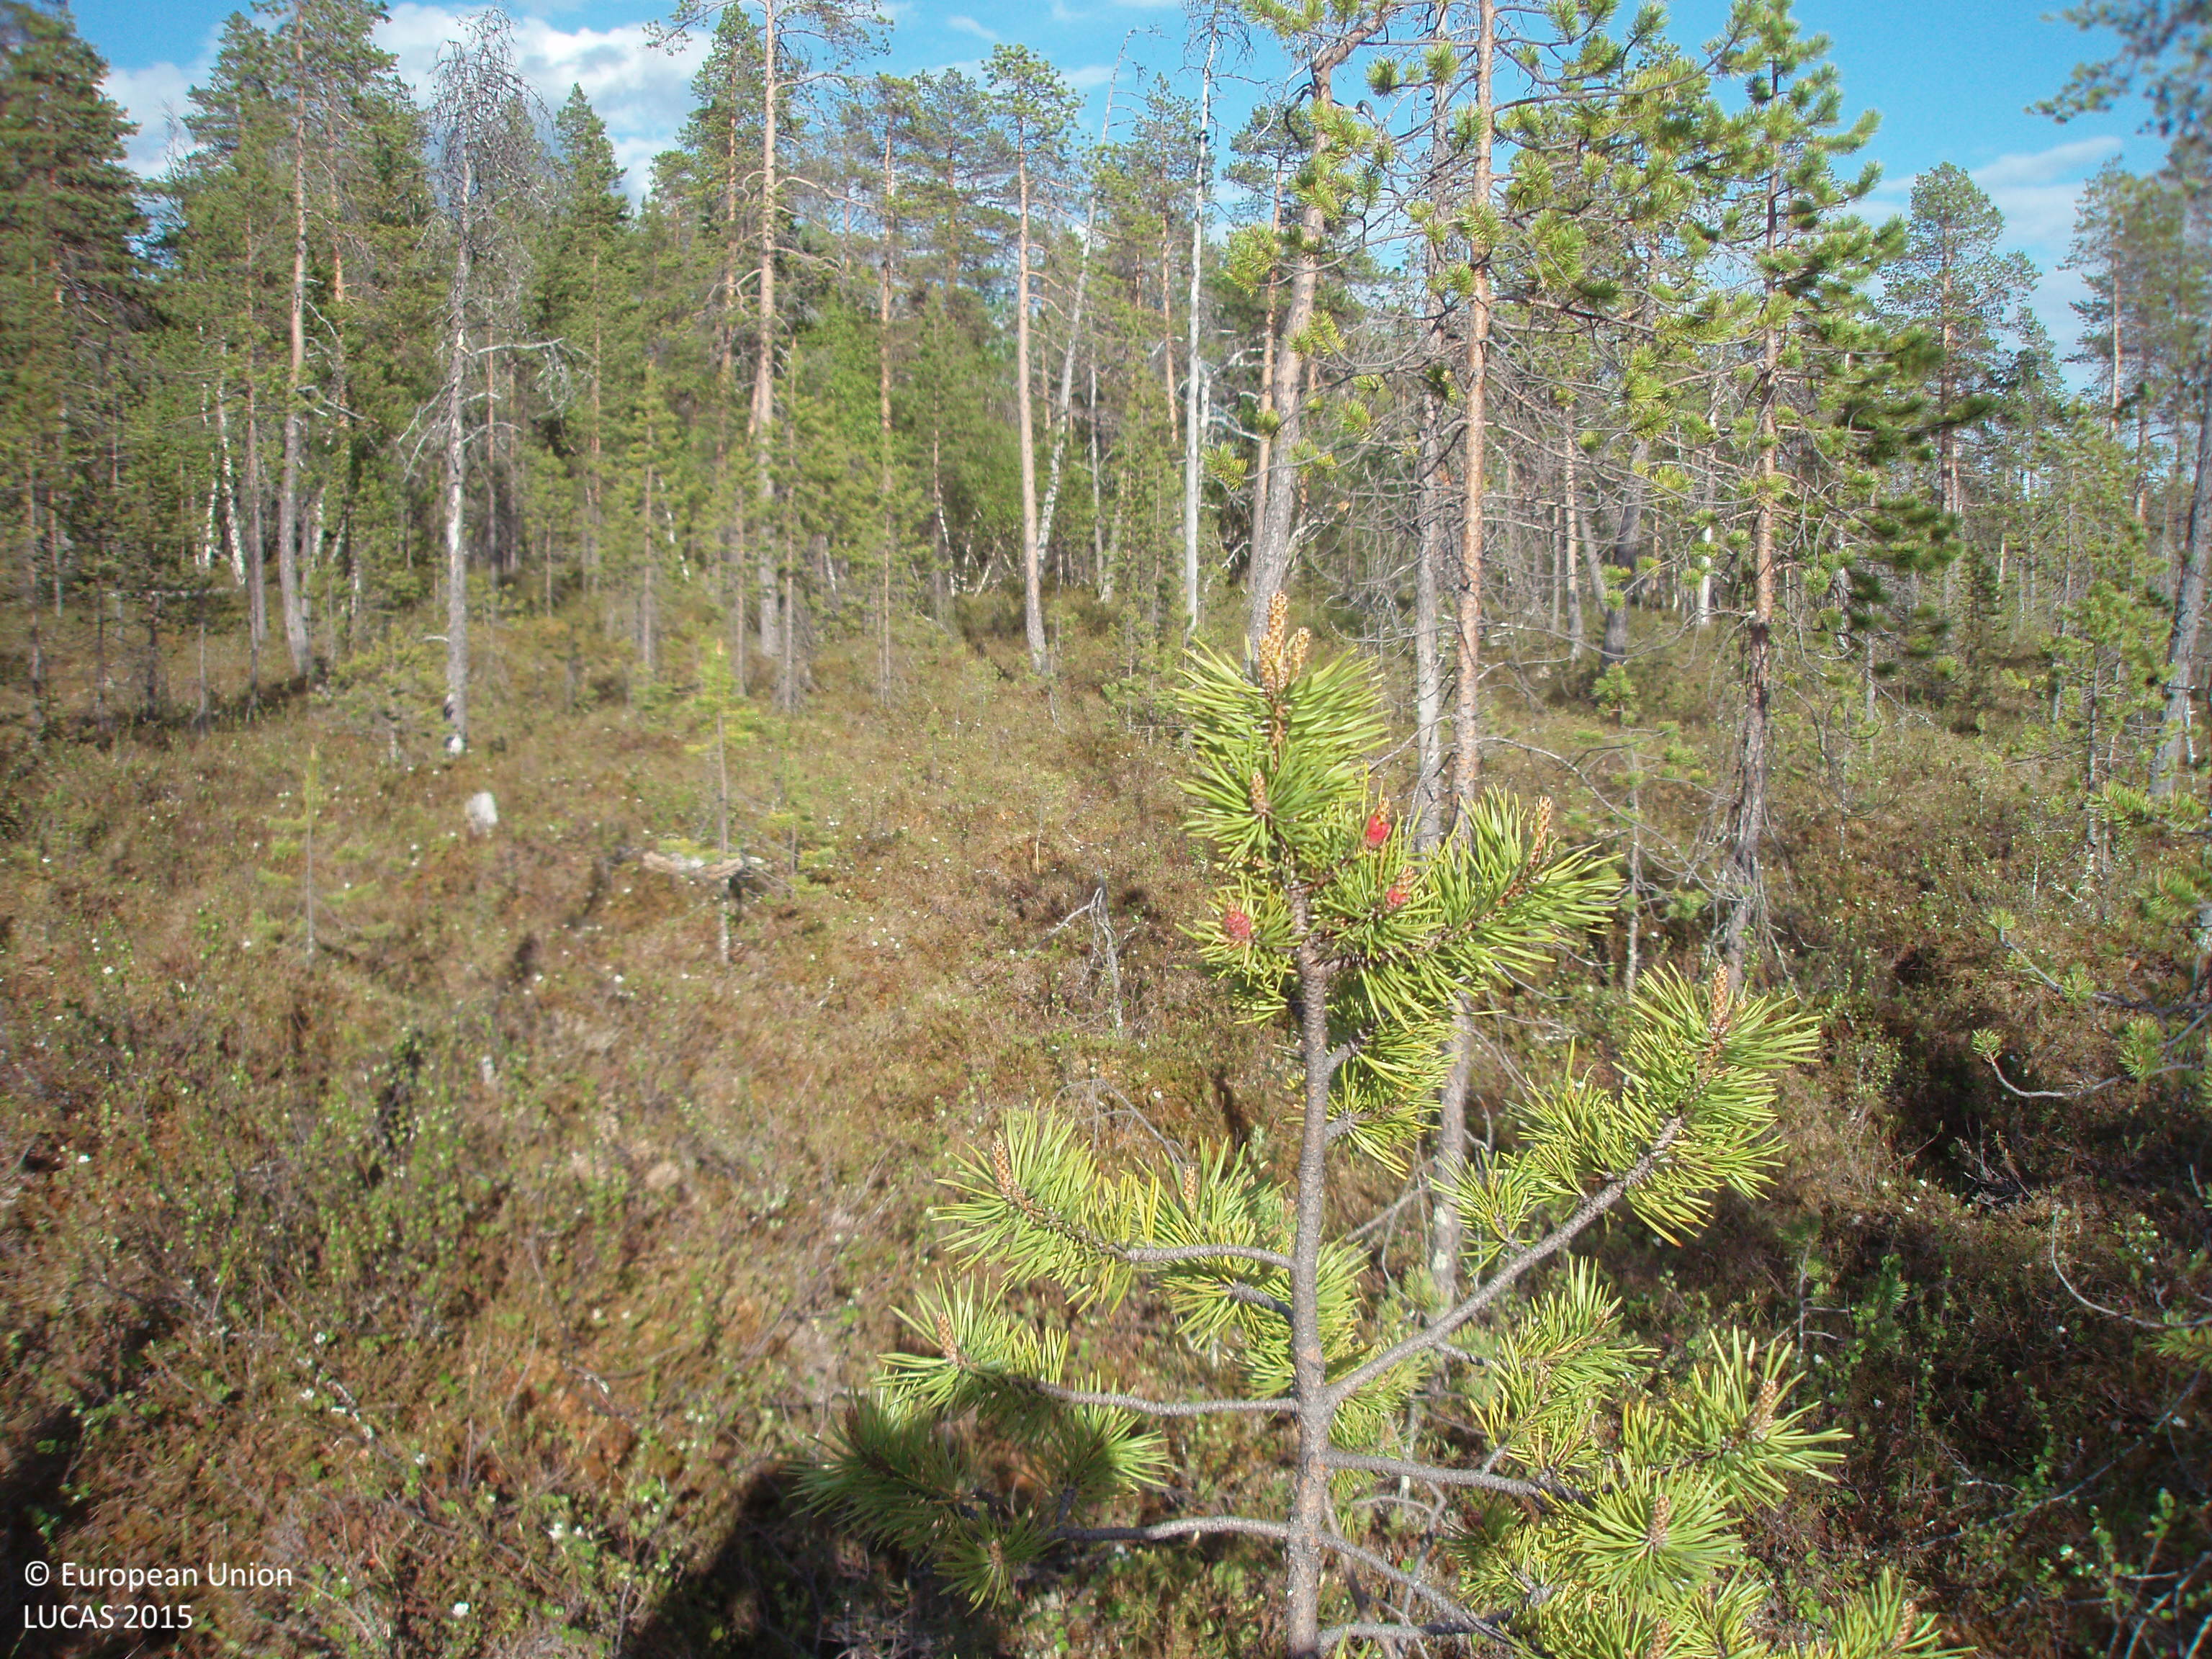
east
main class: Woodland
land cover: Pine dominated coniferous woodland
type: boreal forest
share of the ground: 25 - 50 %
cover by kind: shrubs 60 %, coniferous forest trees 30 %, lichens and mosses 10 %
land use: Semi-natural and natural areas not in use
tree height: > 5 m
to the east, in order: Pine dominated coniferous woodland; Pine dominated mixed woodland; Pine dominated coniferous woodland; Pine dominated mixed woodland; Shruby margins; Paved roads, cycling and walking lanes; Pine dominated coniferous woodland; Tracks; Pine dominated coniferous woodland
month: June
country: FI
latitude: 68.7625
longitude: 28.5350
